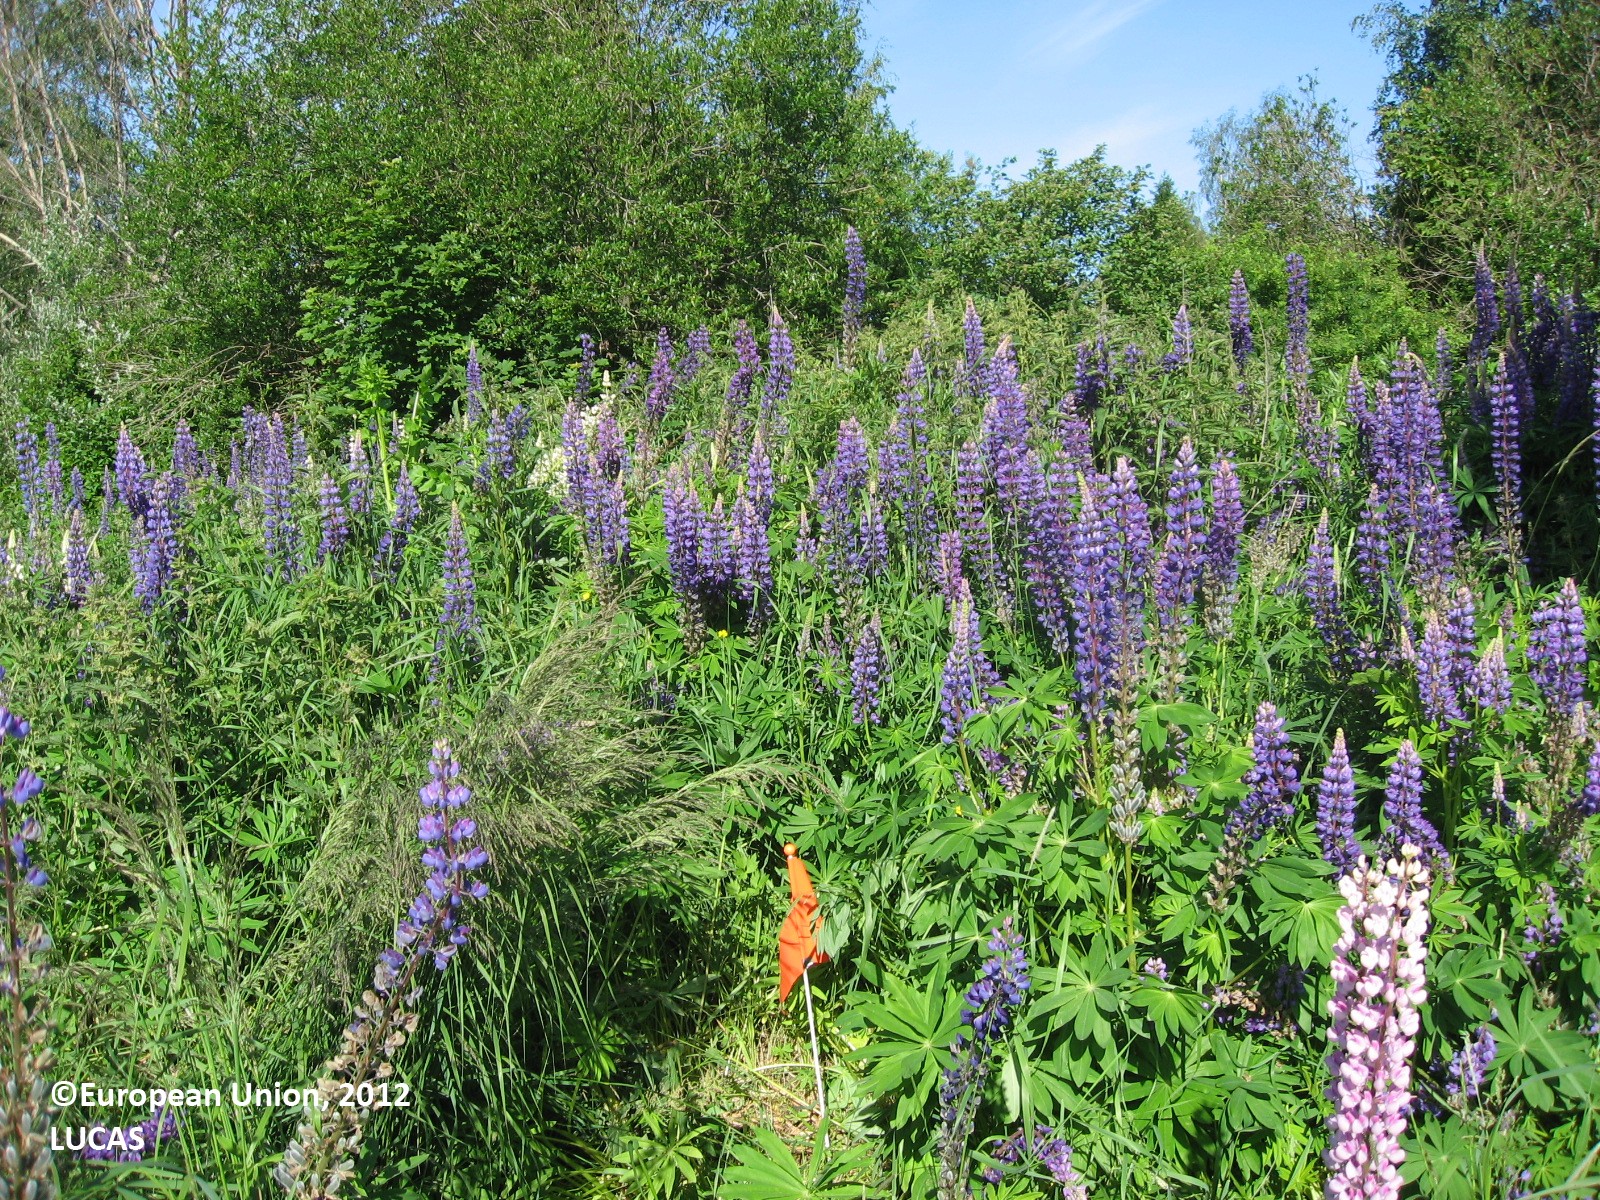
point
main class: Grassland
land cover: Spontaneously vegetated surfaces
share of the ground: > 75 %
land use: Semi-natural and natural areas not in use
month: June
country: FI
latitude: 60.4301
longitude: 26.2262
